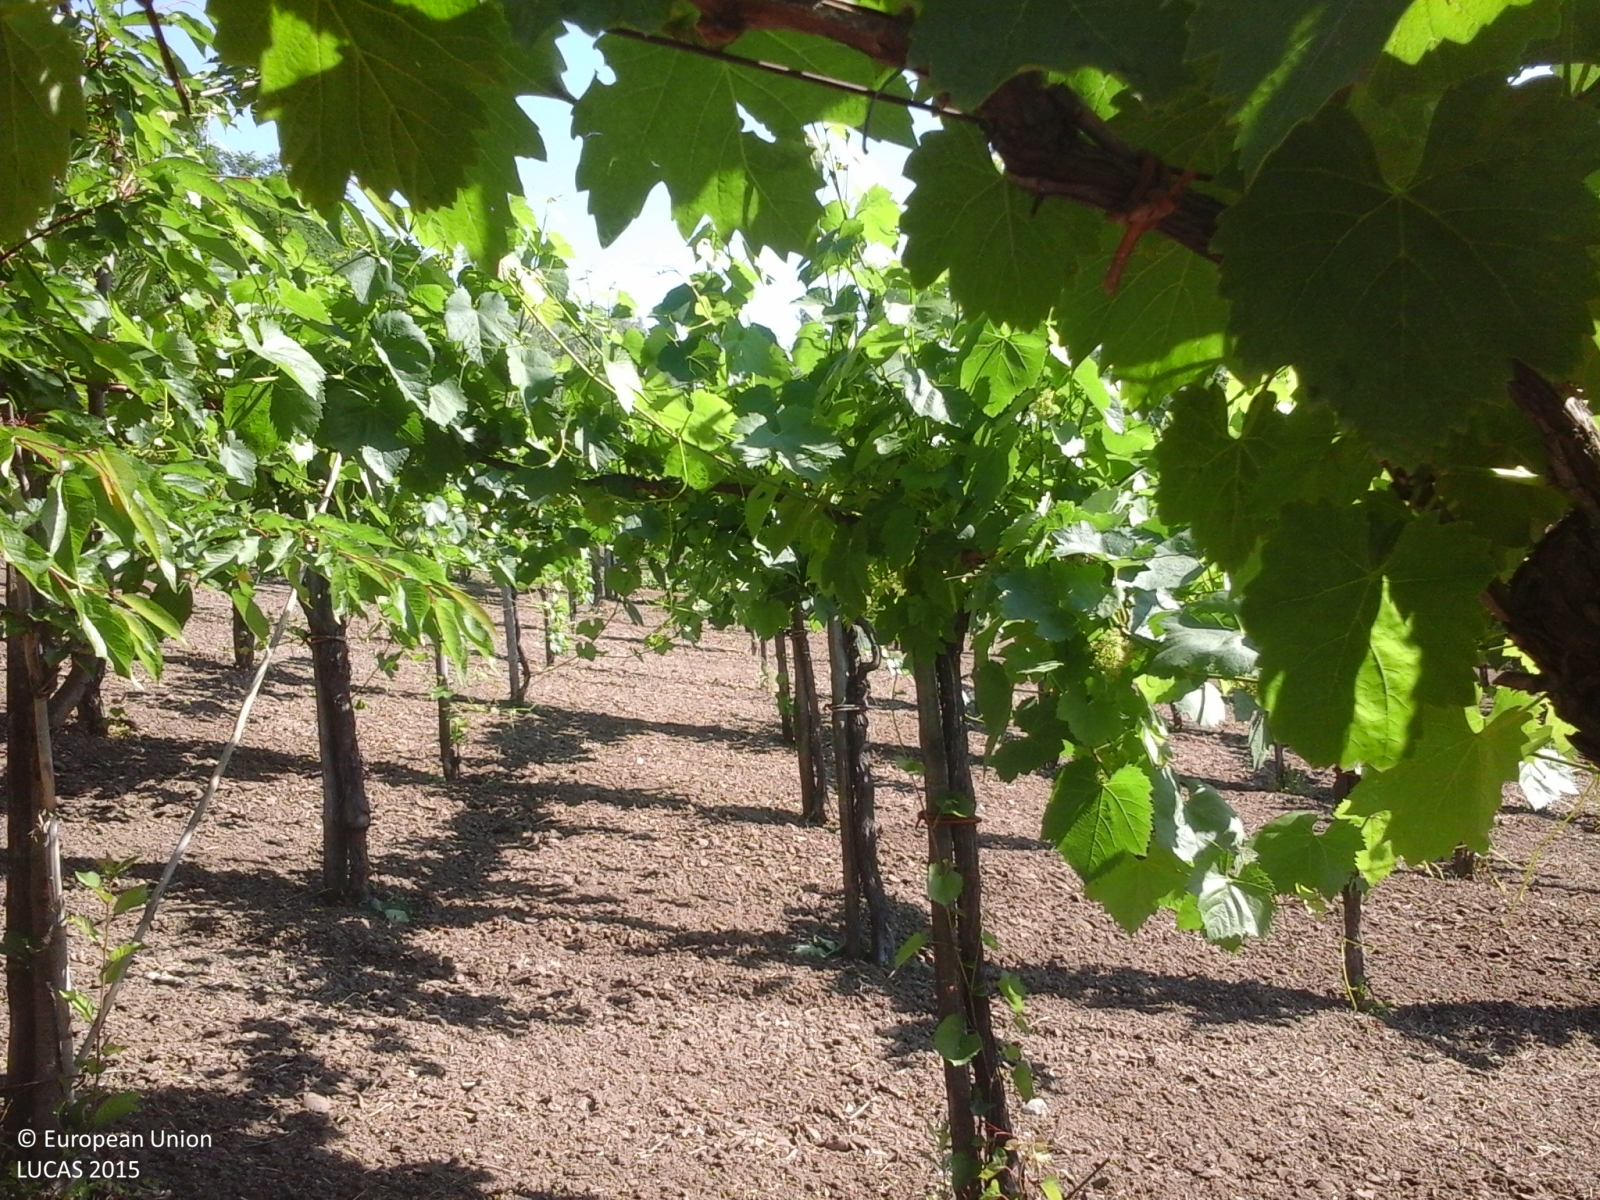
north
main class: Cropland
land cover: Vineyards
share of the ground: > 75 %
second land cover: Other bare soil
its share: > 75 %
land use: Agriculture (excluding fallow land and kitchen gardens)
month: June
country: IT
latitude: 41.1698
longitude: 14.6903
